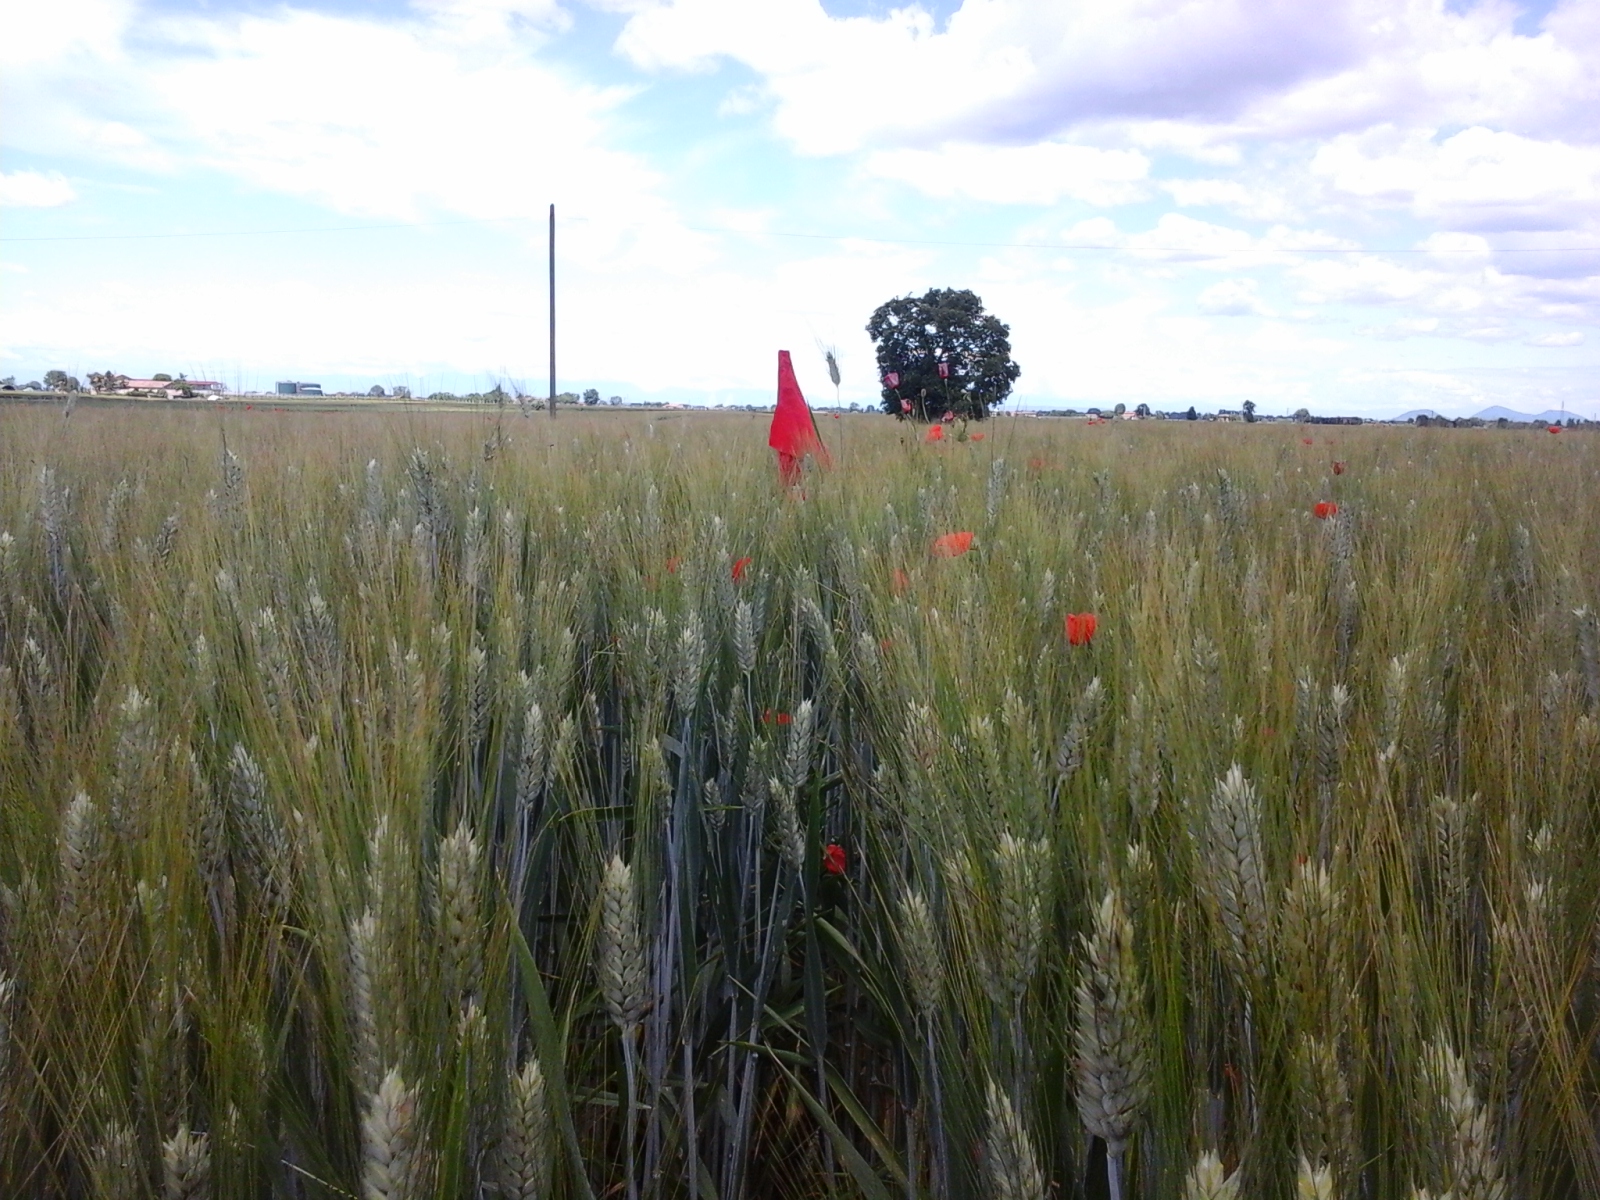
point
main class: Cropland
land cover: Durum wheat
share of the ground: > 75 %
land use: Agriculture (excluding fallow land and kitchen gardens)
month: May
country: IT
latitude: 45.0422
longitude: 11.5586
